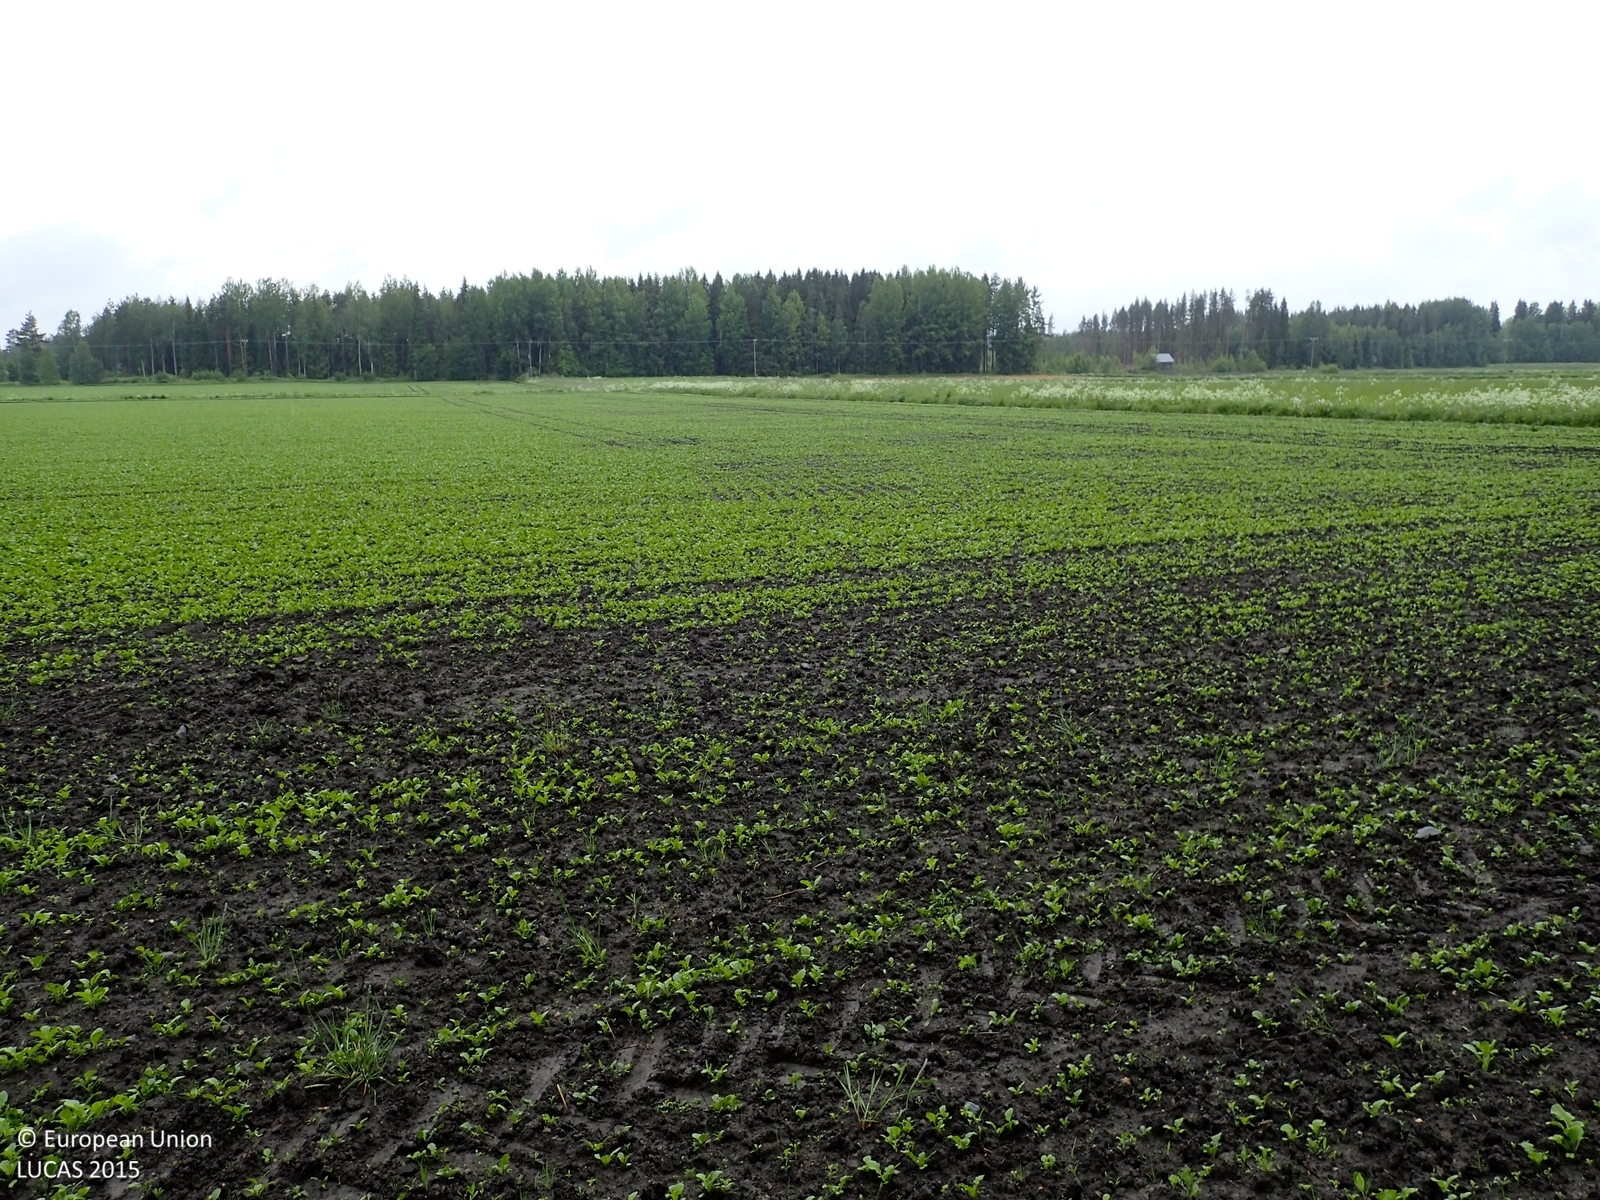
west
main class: Cropland
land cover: Rape and turnip rape
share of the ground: 50 - 75 %
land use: Agriculture (excluding fallow land and kitchen gardens)
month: June
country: FI
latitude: 62.2199
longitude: 21.5664
